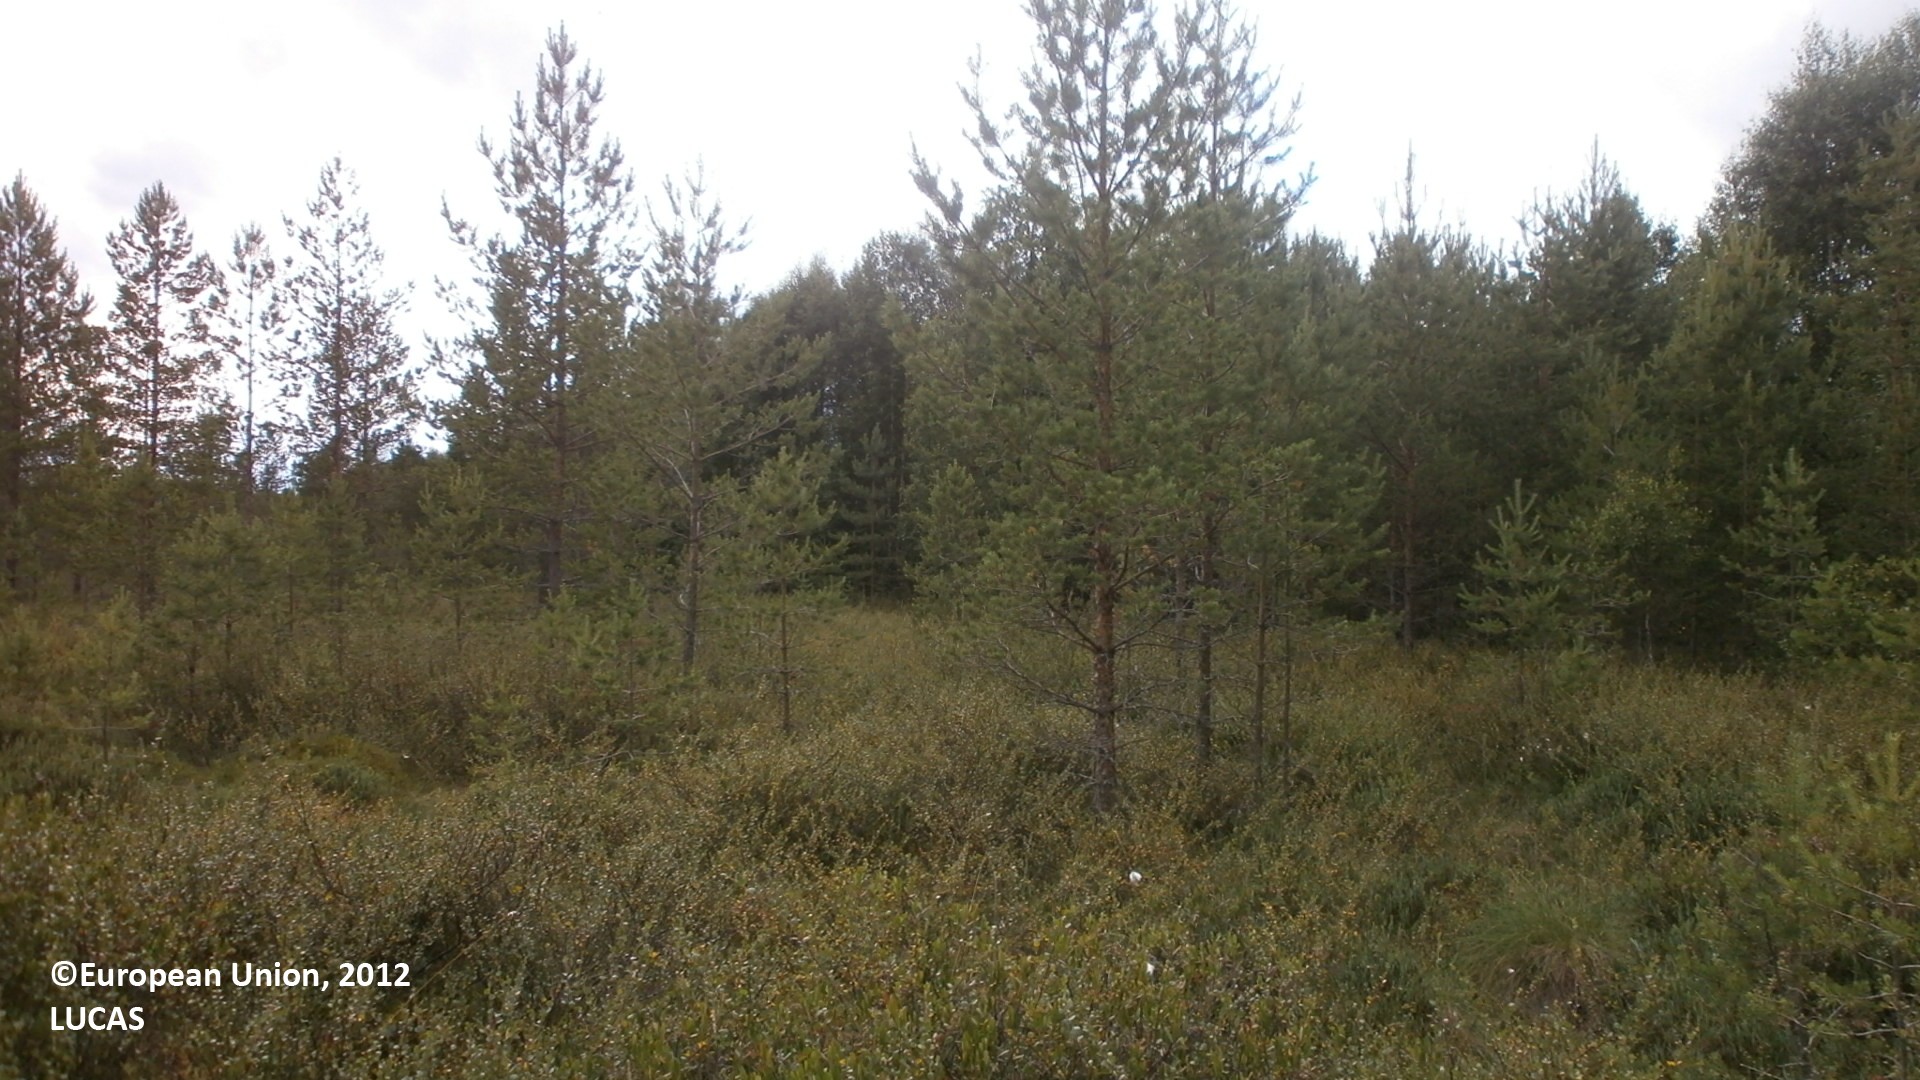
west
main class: Woodland
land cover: Pine dominated coniferous woodland
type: mire and swamp forests
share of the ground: 10 - 25 %
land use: Forestry
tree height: > 5 m
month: July
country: FI
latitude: 63.9526
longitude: 24.2564
